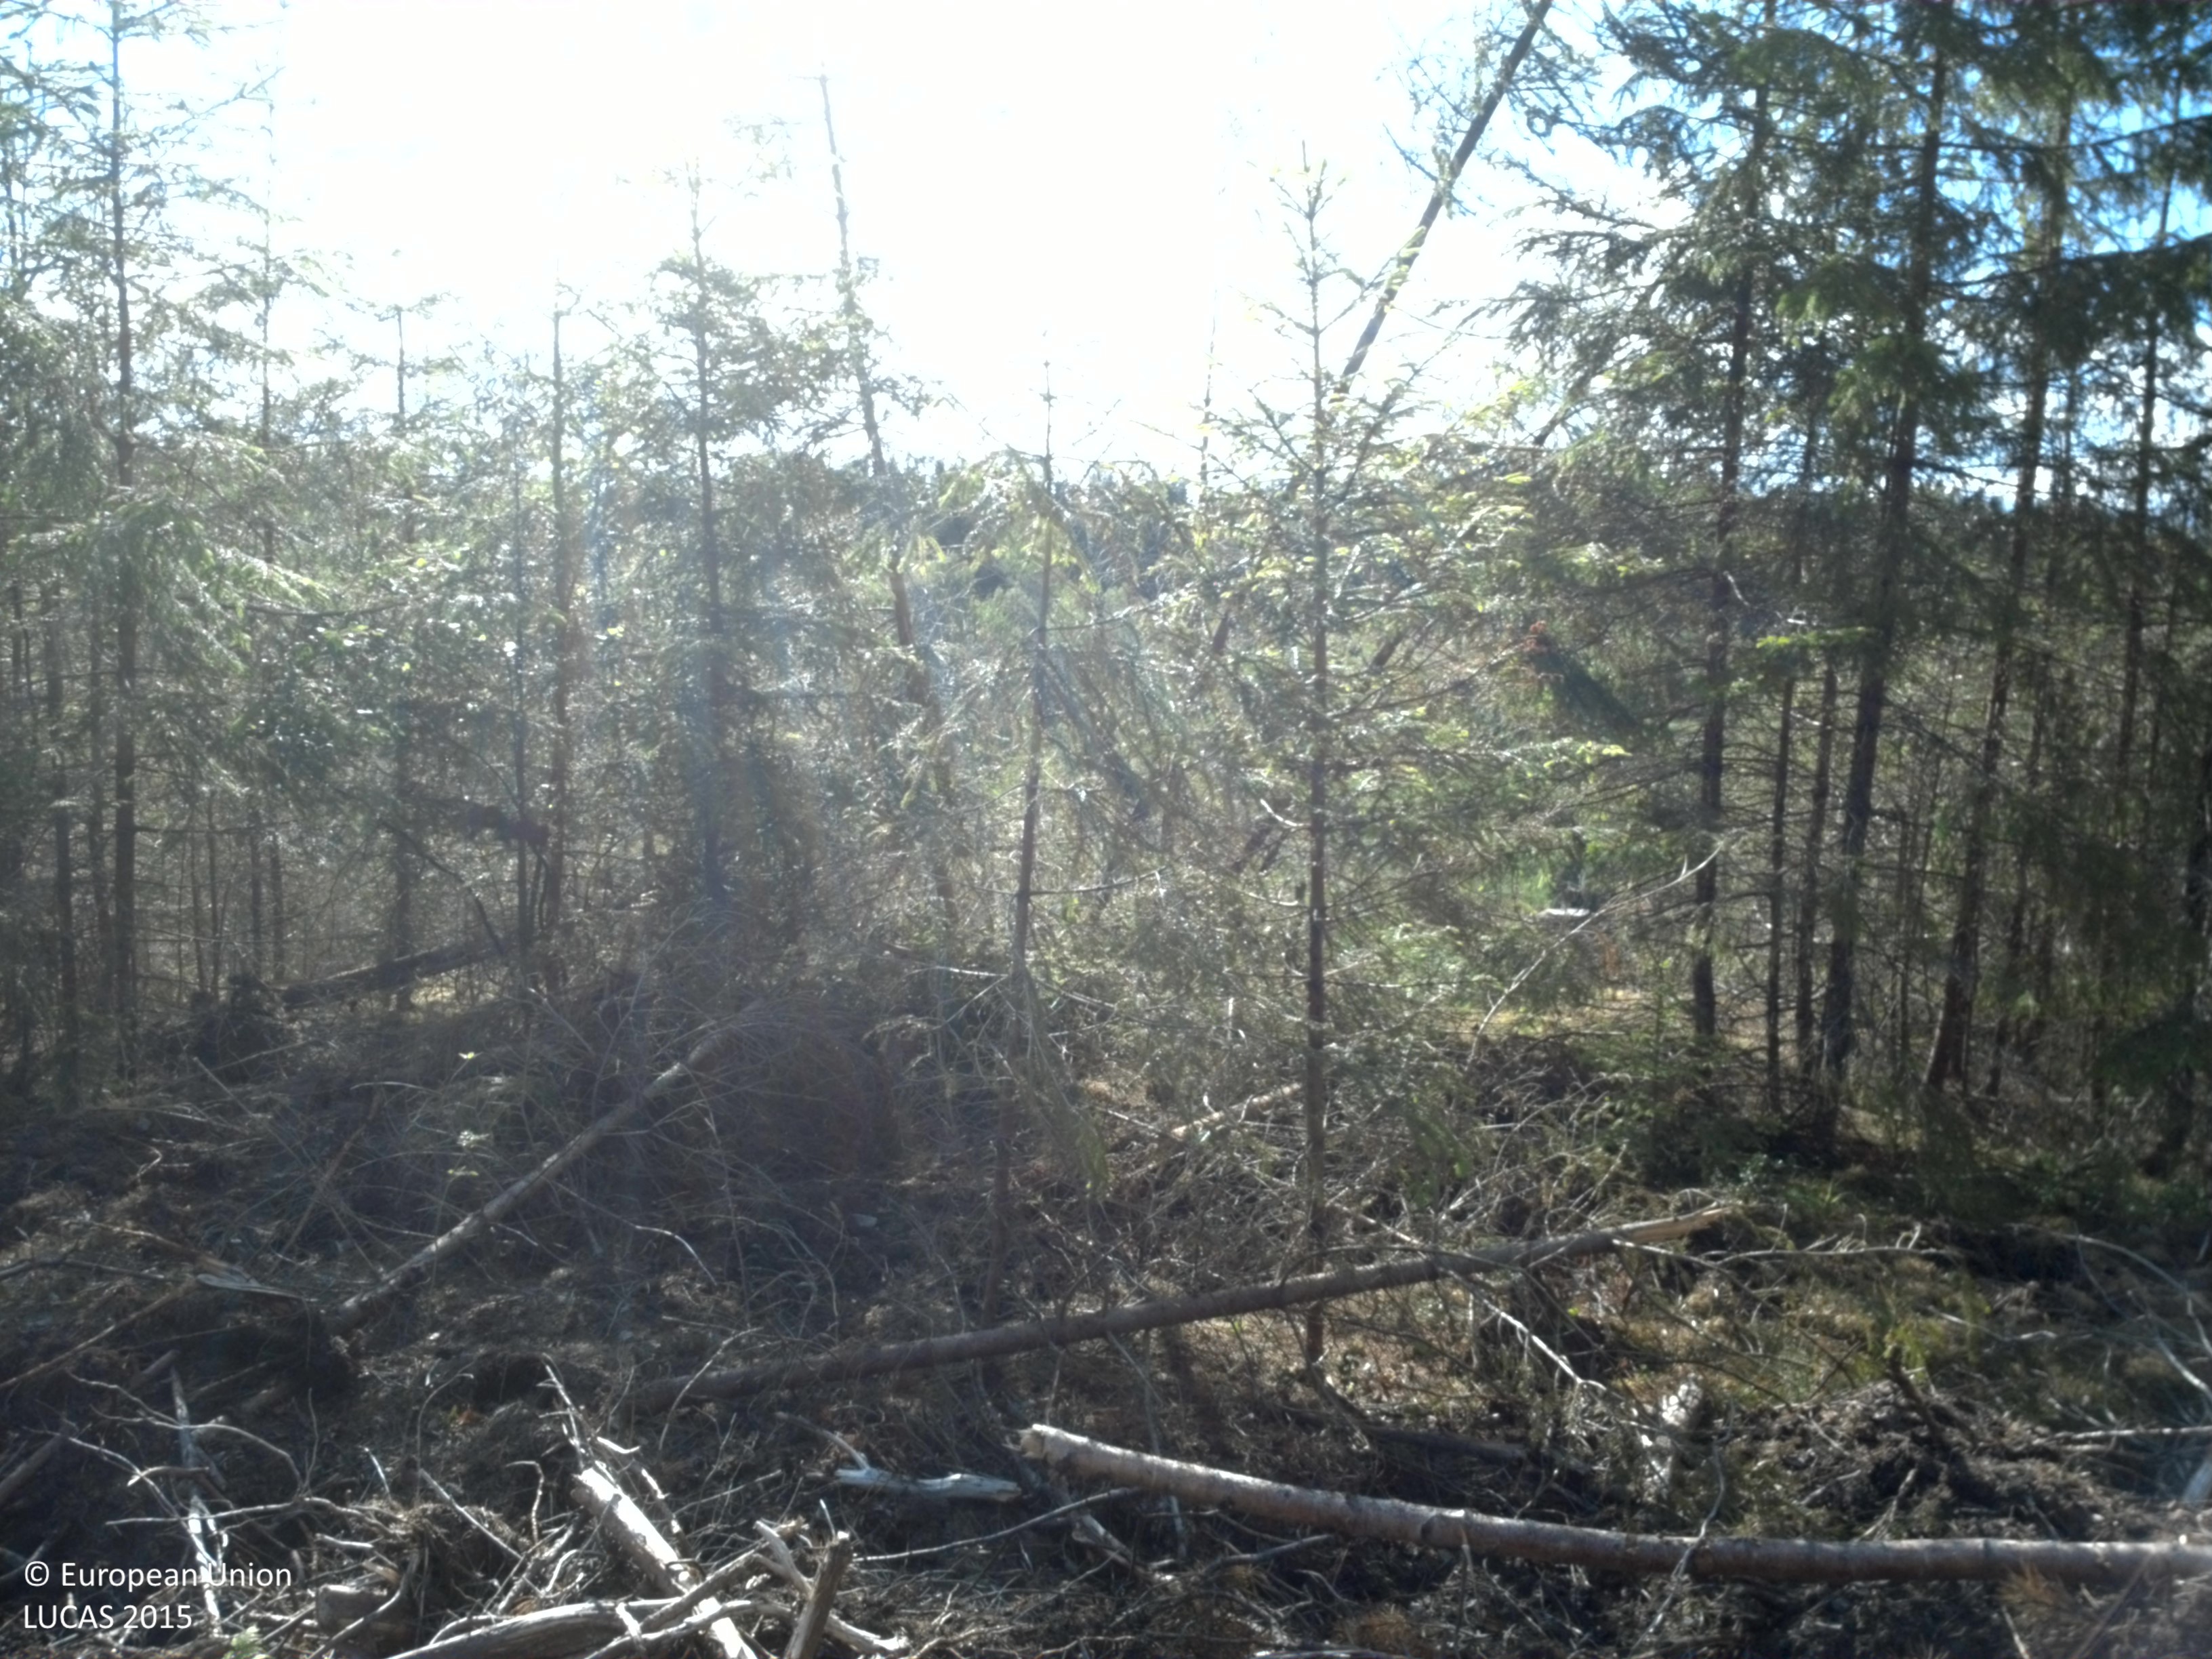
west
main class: Woodland
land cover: Spruce dominated coniferous woodland
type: boreal forest
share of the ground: 10 - 25 %
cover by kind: consolidated bare surface 80 %, coniferous forest trees 10 %, herbaceous plants 10 %
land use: Forestry
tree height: < 5 m
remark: Clear cut
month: June
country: SE
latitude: 58.5725
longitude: 15.5823
